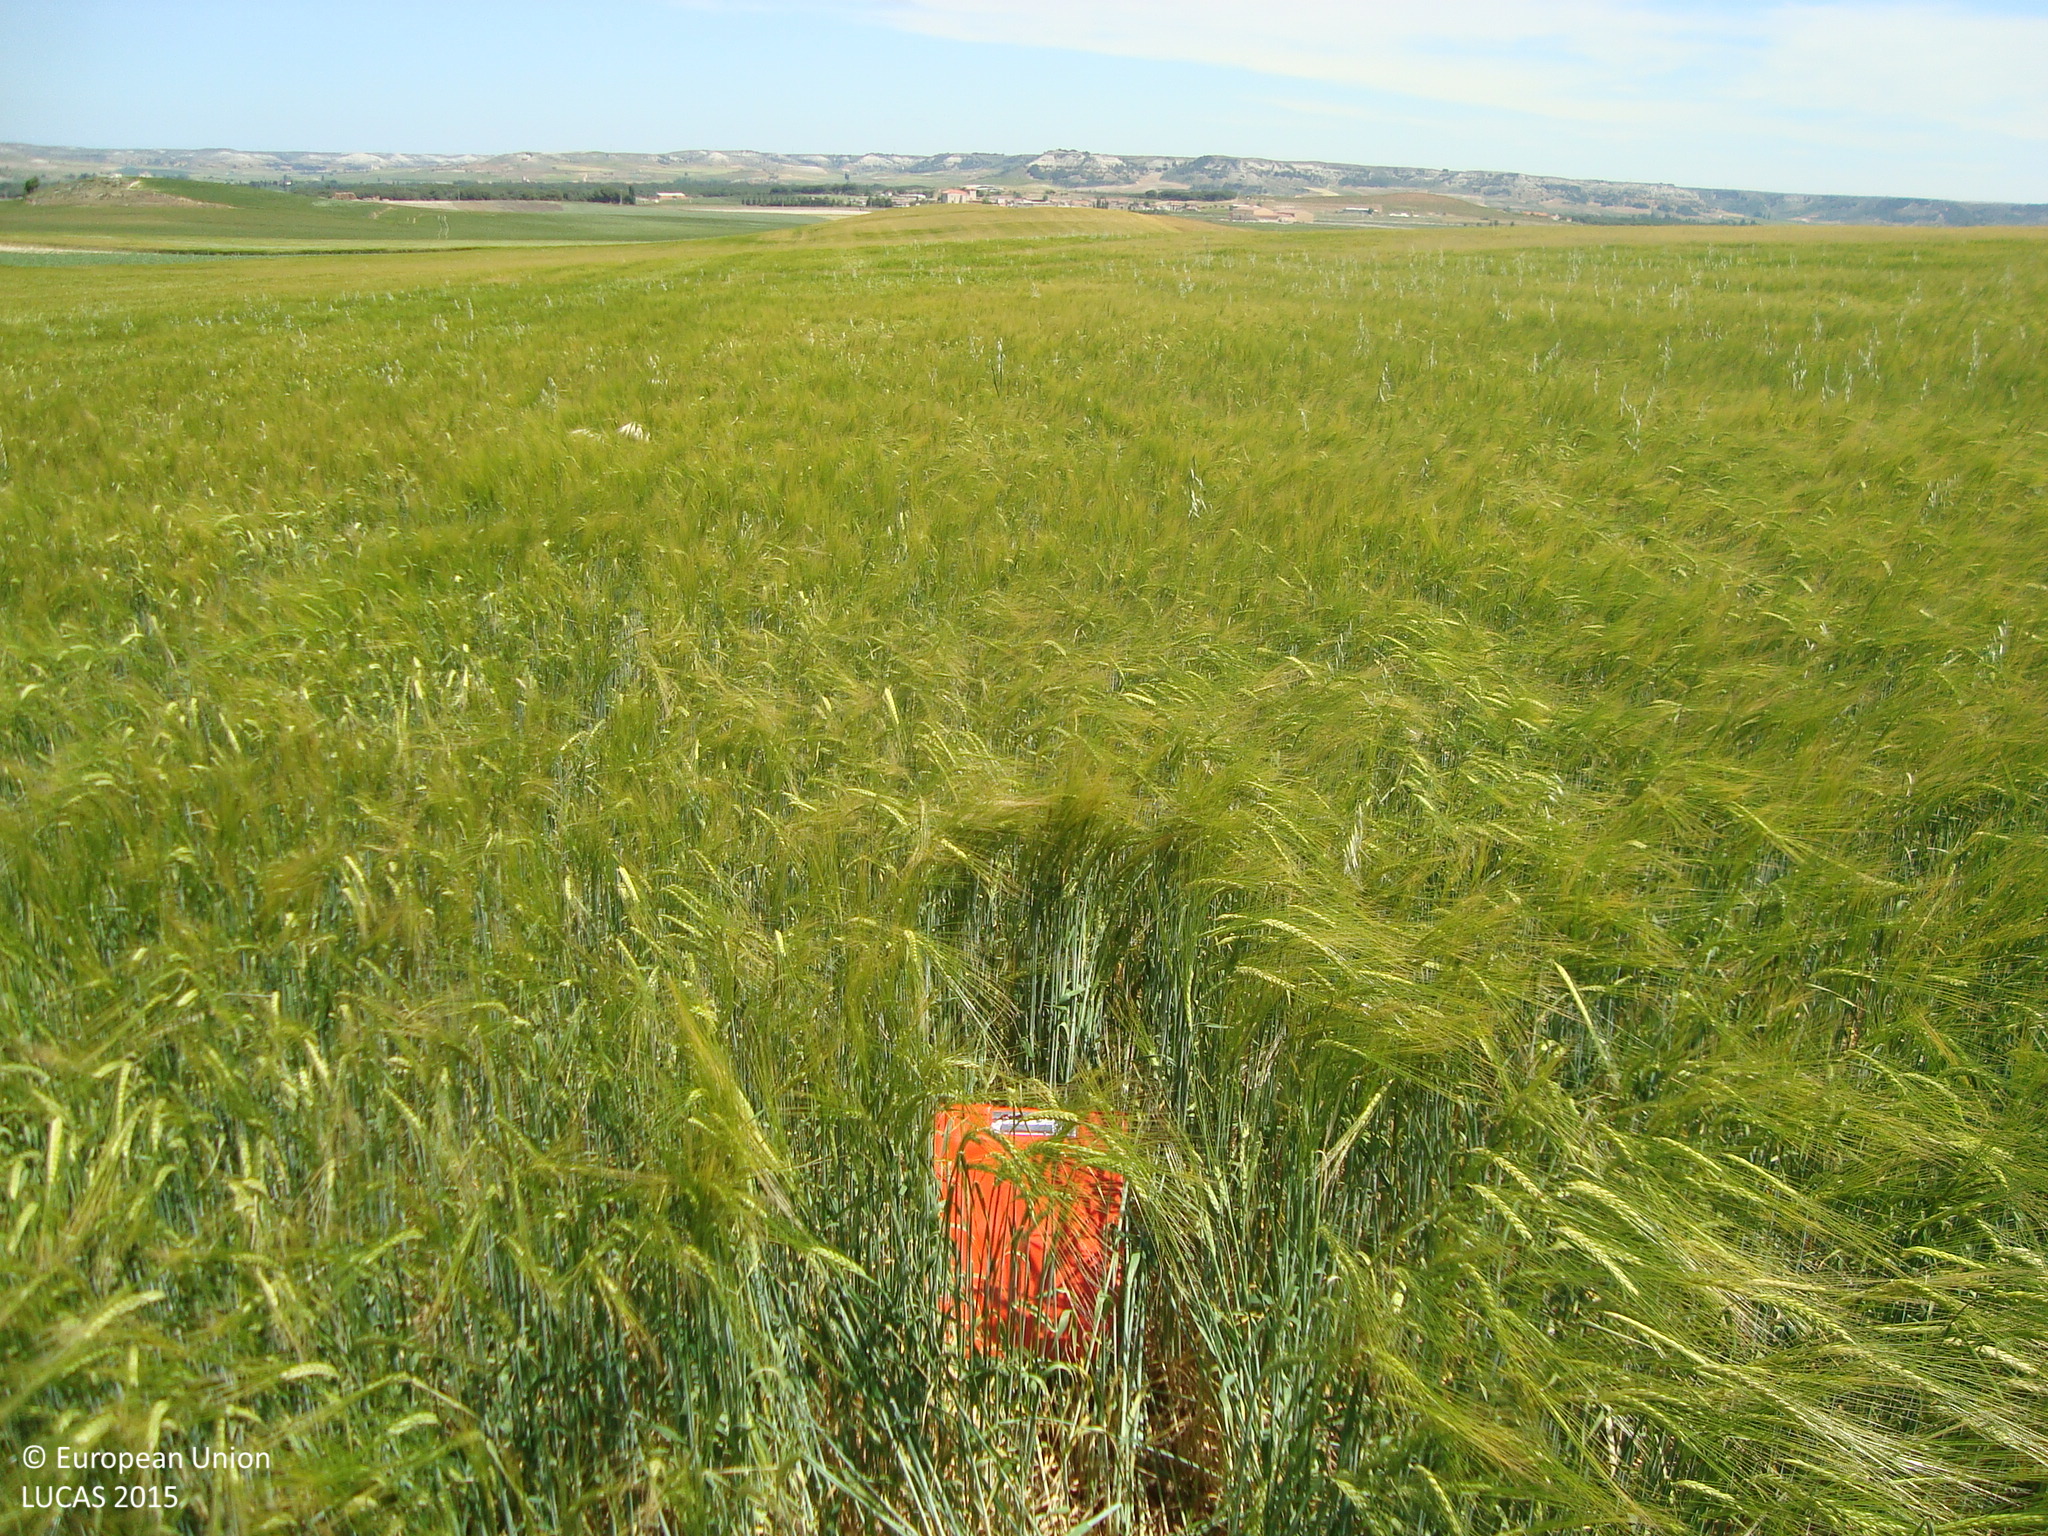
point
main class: Cropland
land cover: Barley
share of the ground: > 75 %
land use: Agriculture (excluding fallow land and kitchen gardens)
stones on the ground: < 10 %
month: May
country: ES
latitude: 41.5957
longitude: -4.1800
